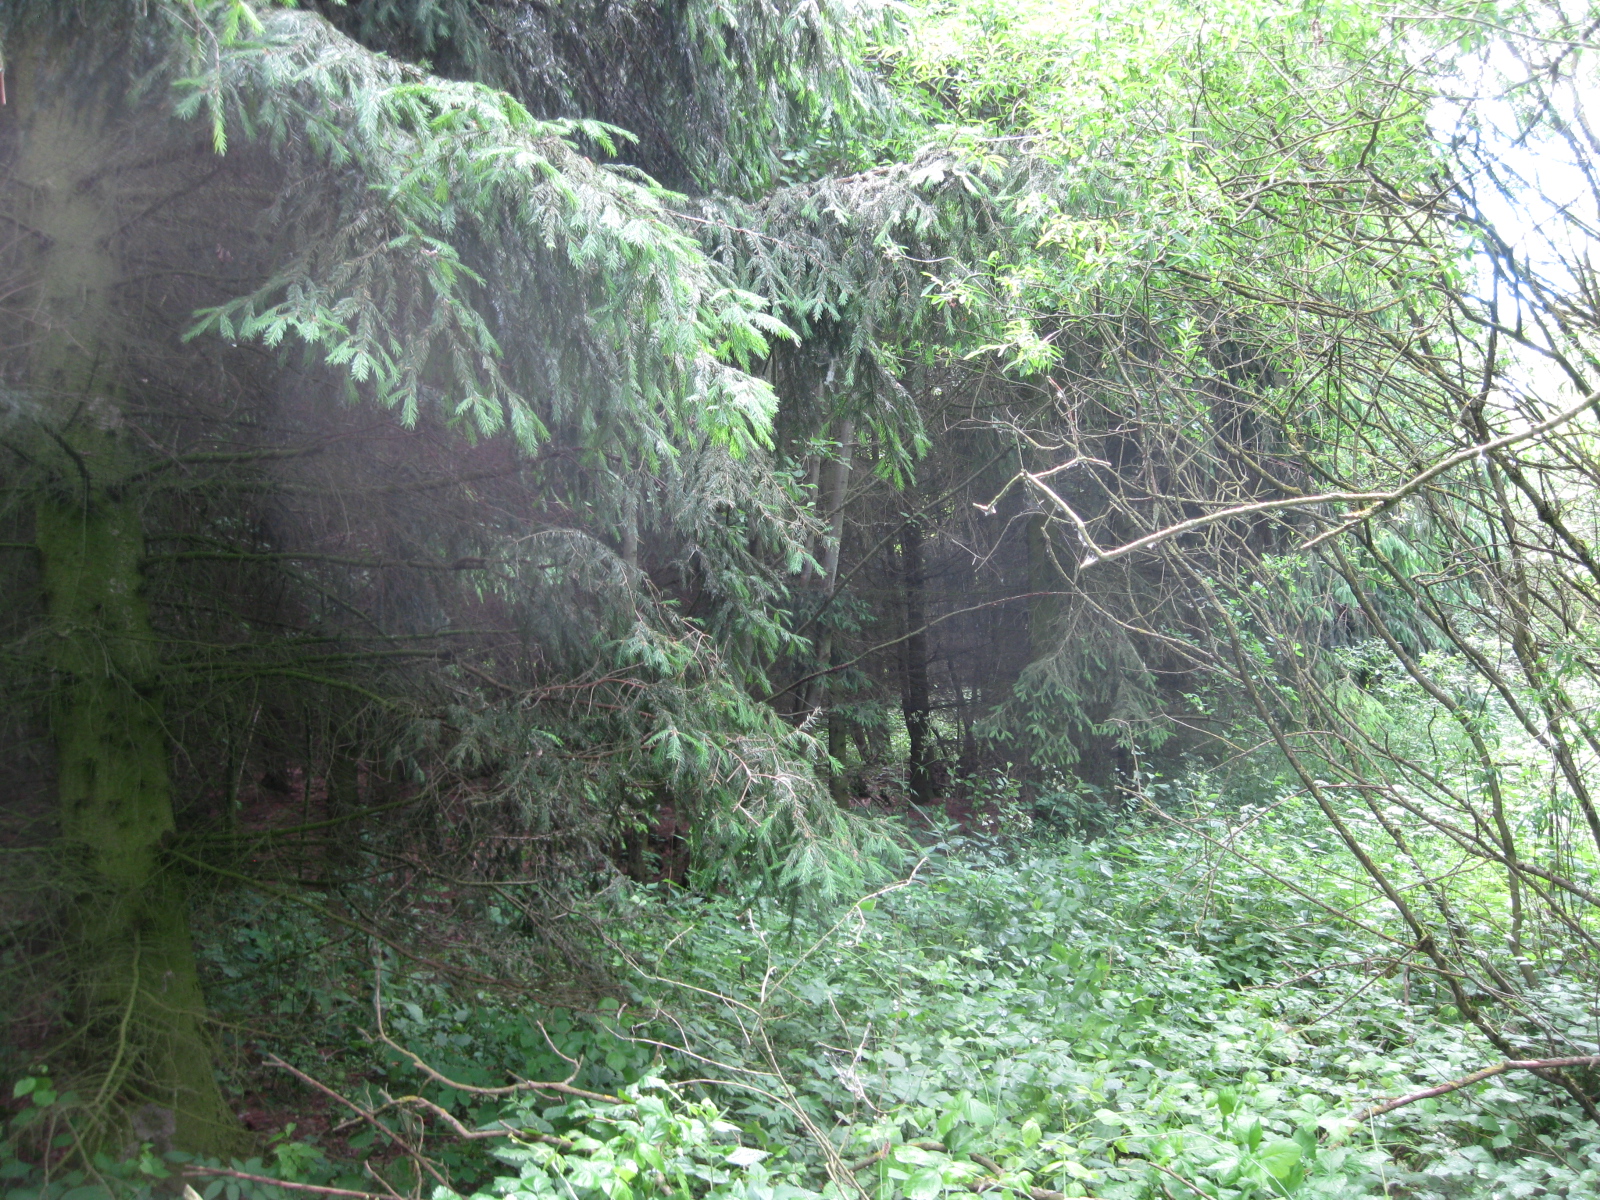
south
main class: Woodland
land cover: Broadleaved woodland
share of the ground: > 75 %
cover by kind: broadleaved forest trees 80 %, herbaceous plants 10 %, coniferous forest trees 5 %, shrubs 5 %
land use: Forestry
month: June
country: LT
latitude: 55.2914
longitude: 24.1235
